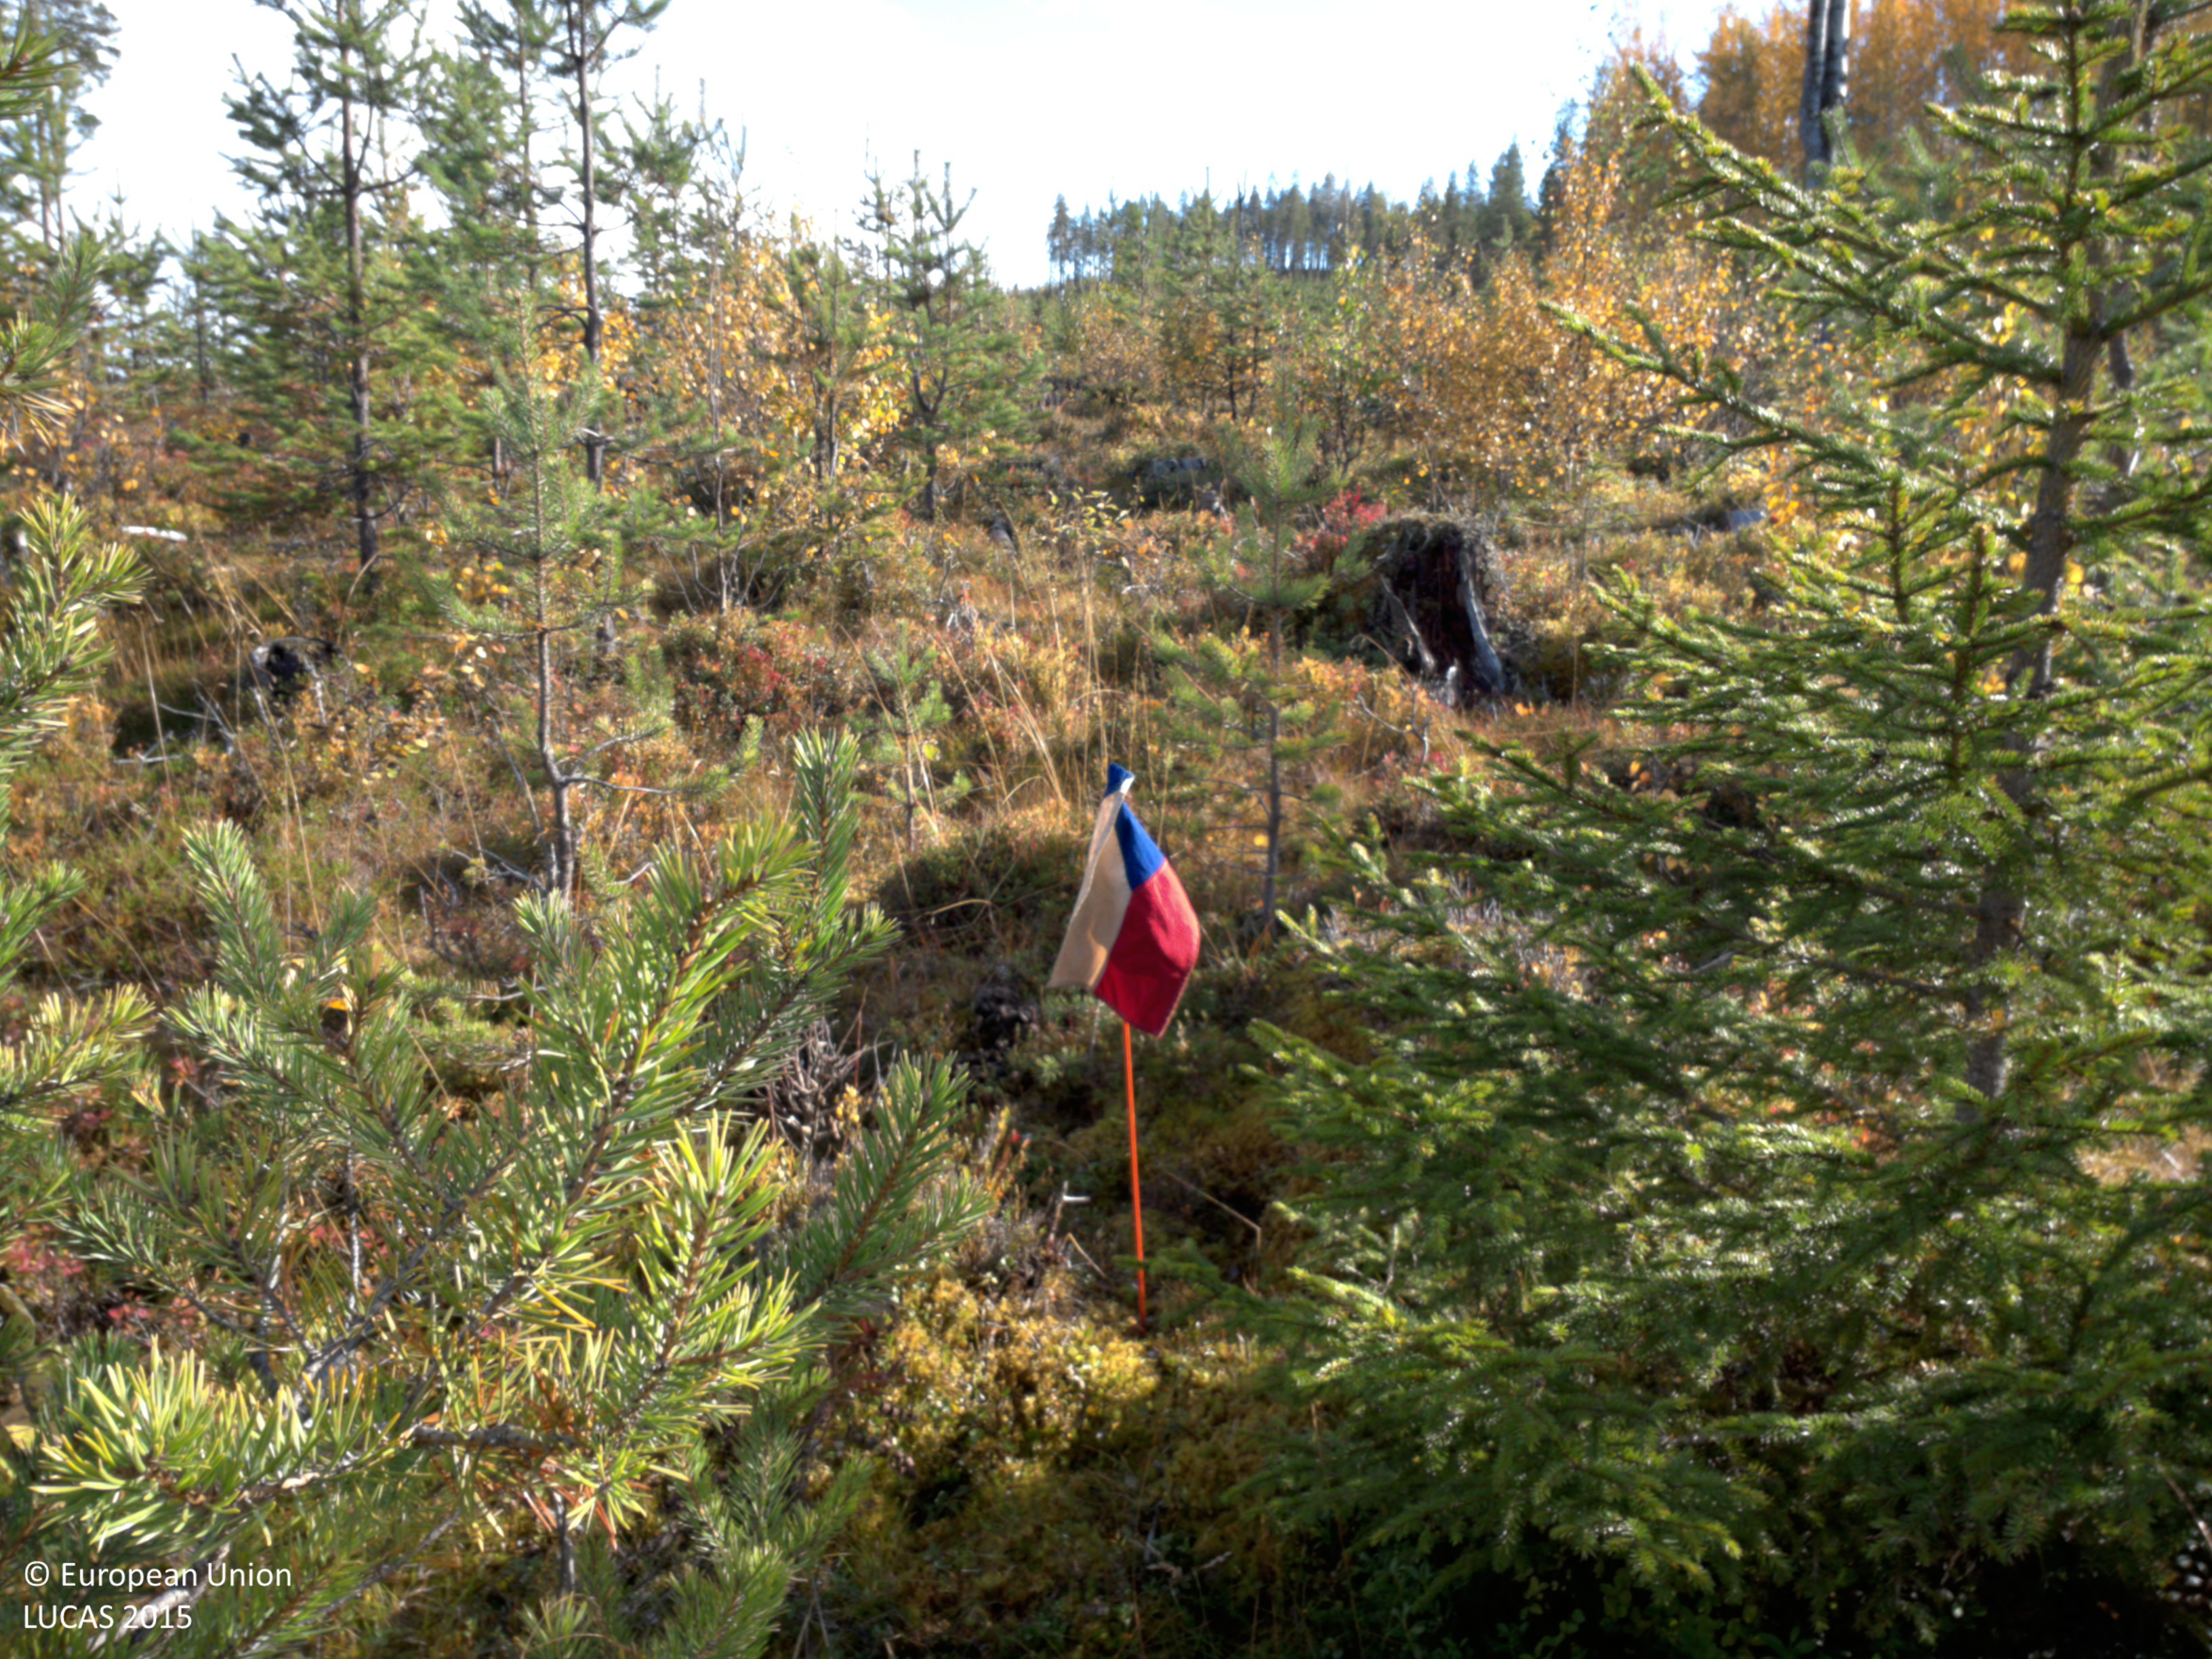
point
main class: Woodland
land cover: Other mixed woodland
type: boreal forest
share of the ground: 50 - 75 %
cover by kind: coniferous forest trees 50 %, broadleaved forest trees 25 %, shrubs 15 %, herbaceous plants 5 %, lichens and mosses 5 %
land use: Forestry
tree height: < 5 m
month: September
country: SE
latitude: 64.7728
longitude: 19.1151
